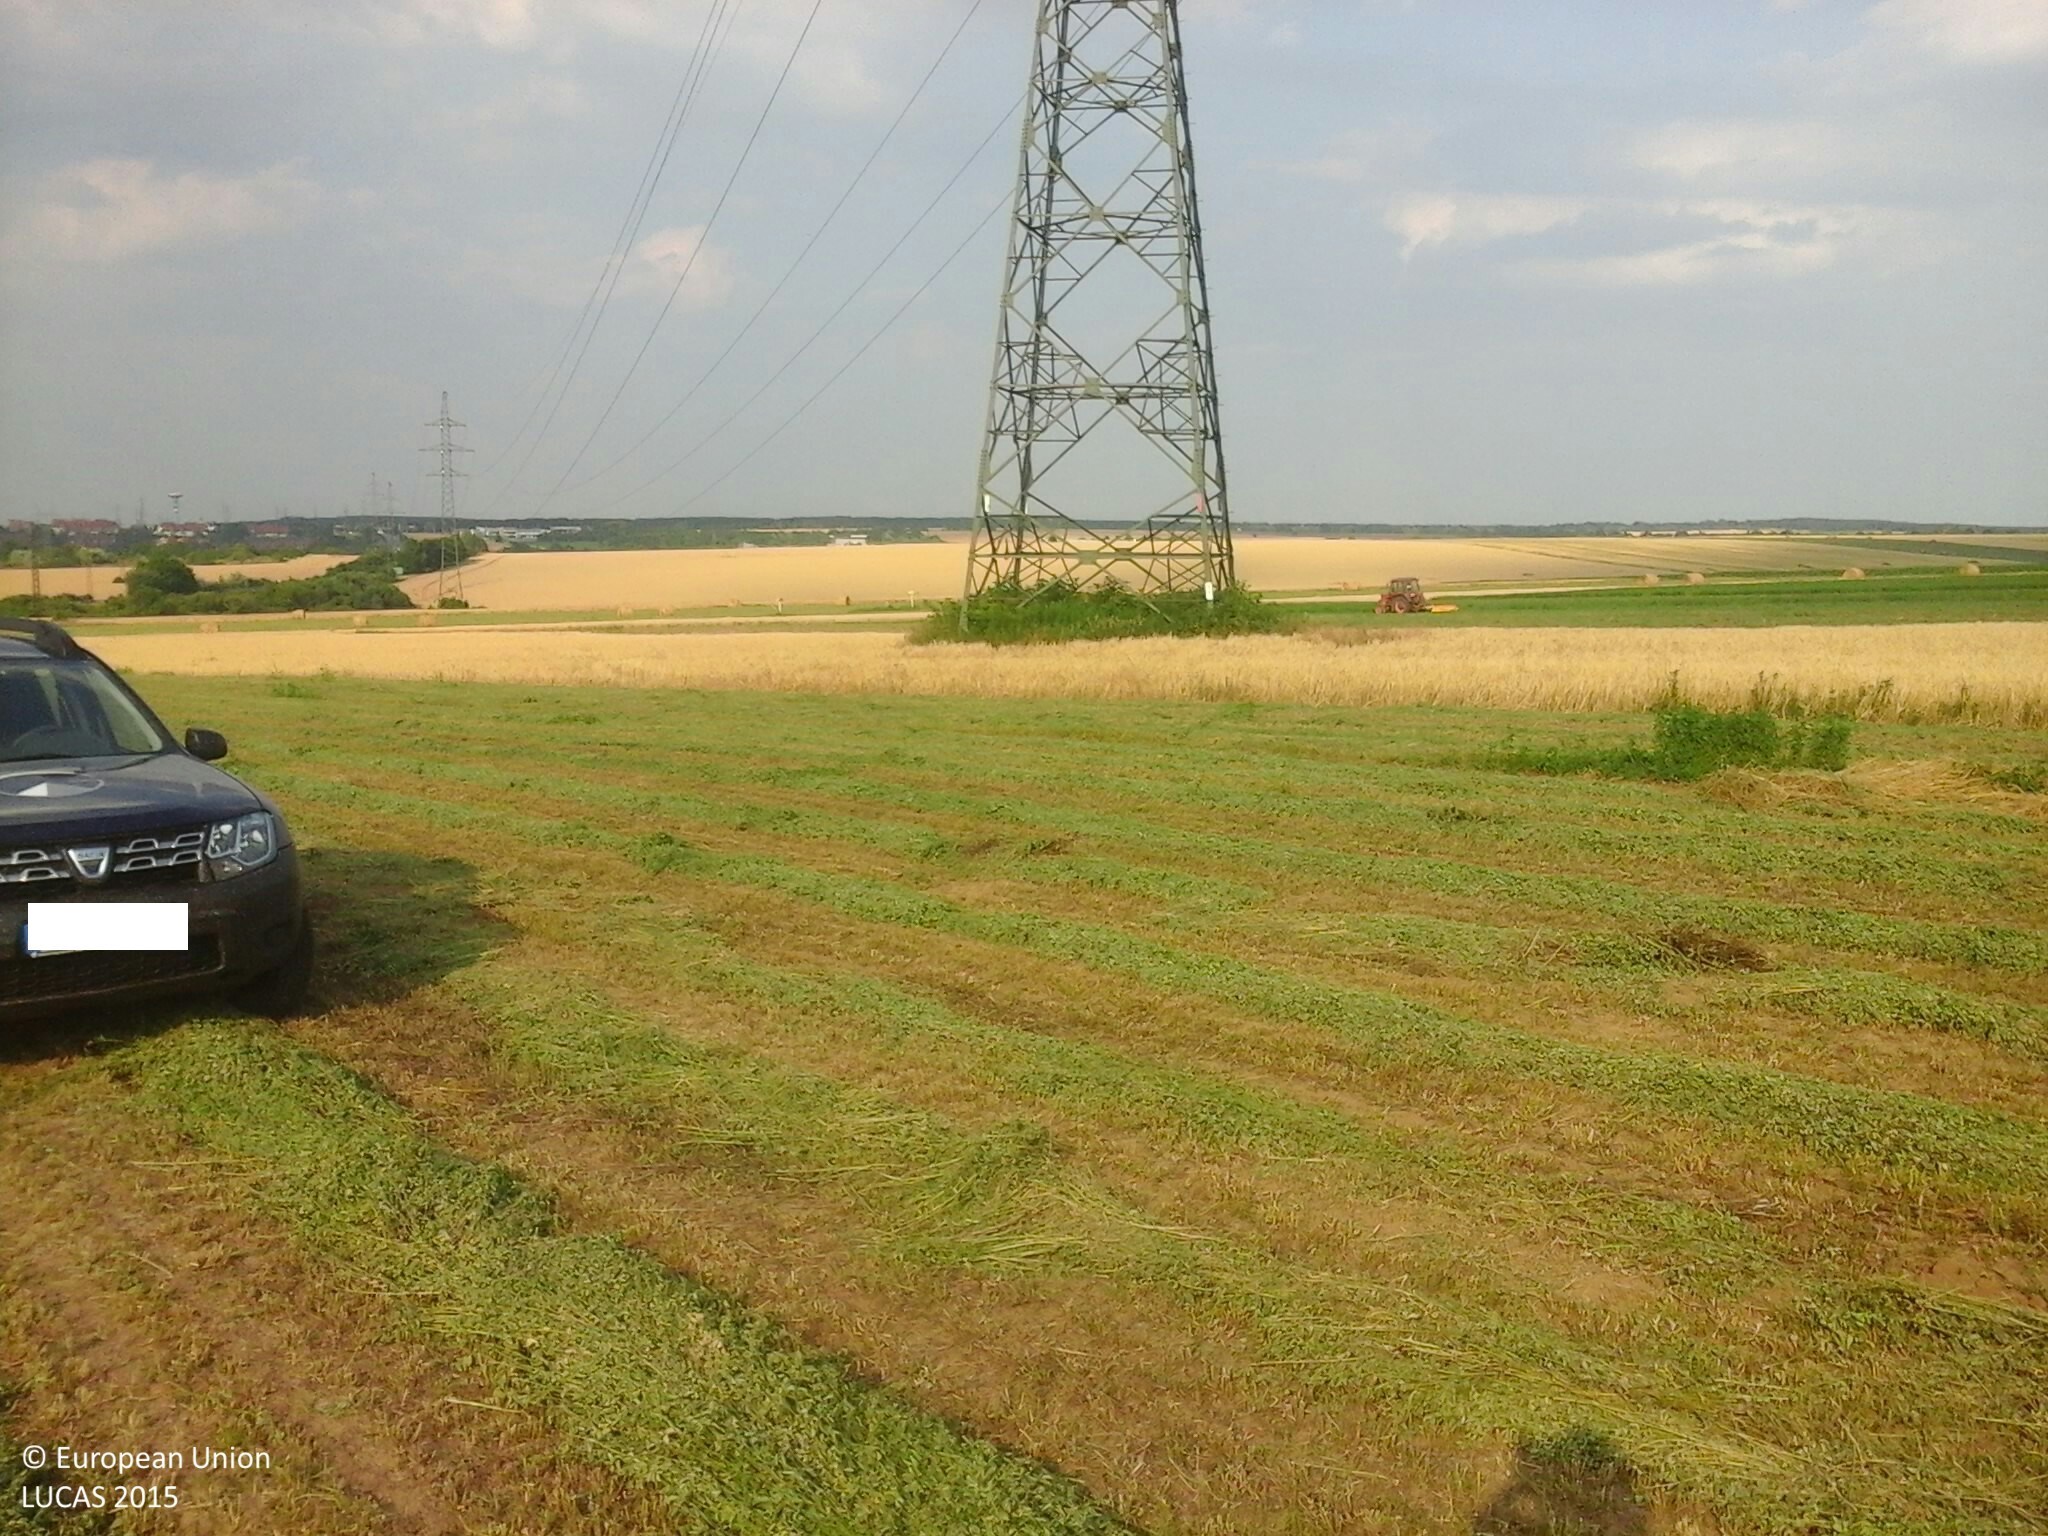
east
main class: Cropland
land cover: Lucerne
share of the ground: 25 - 50 %
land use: Agriculture (excluding fallow land and kitchen gardens)
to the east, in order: Lucerne; Common wheat; Electric lines; Lucerne; Common wheat; Lucerne
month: July
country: HU
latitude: 47.0720
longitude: 17.8969
